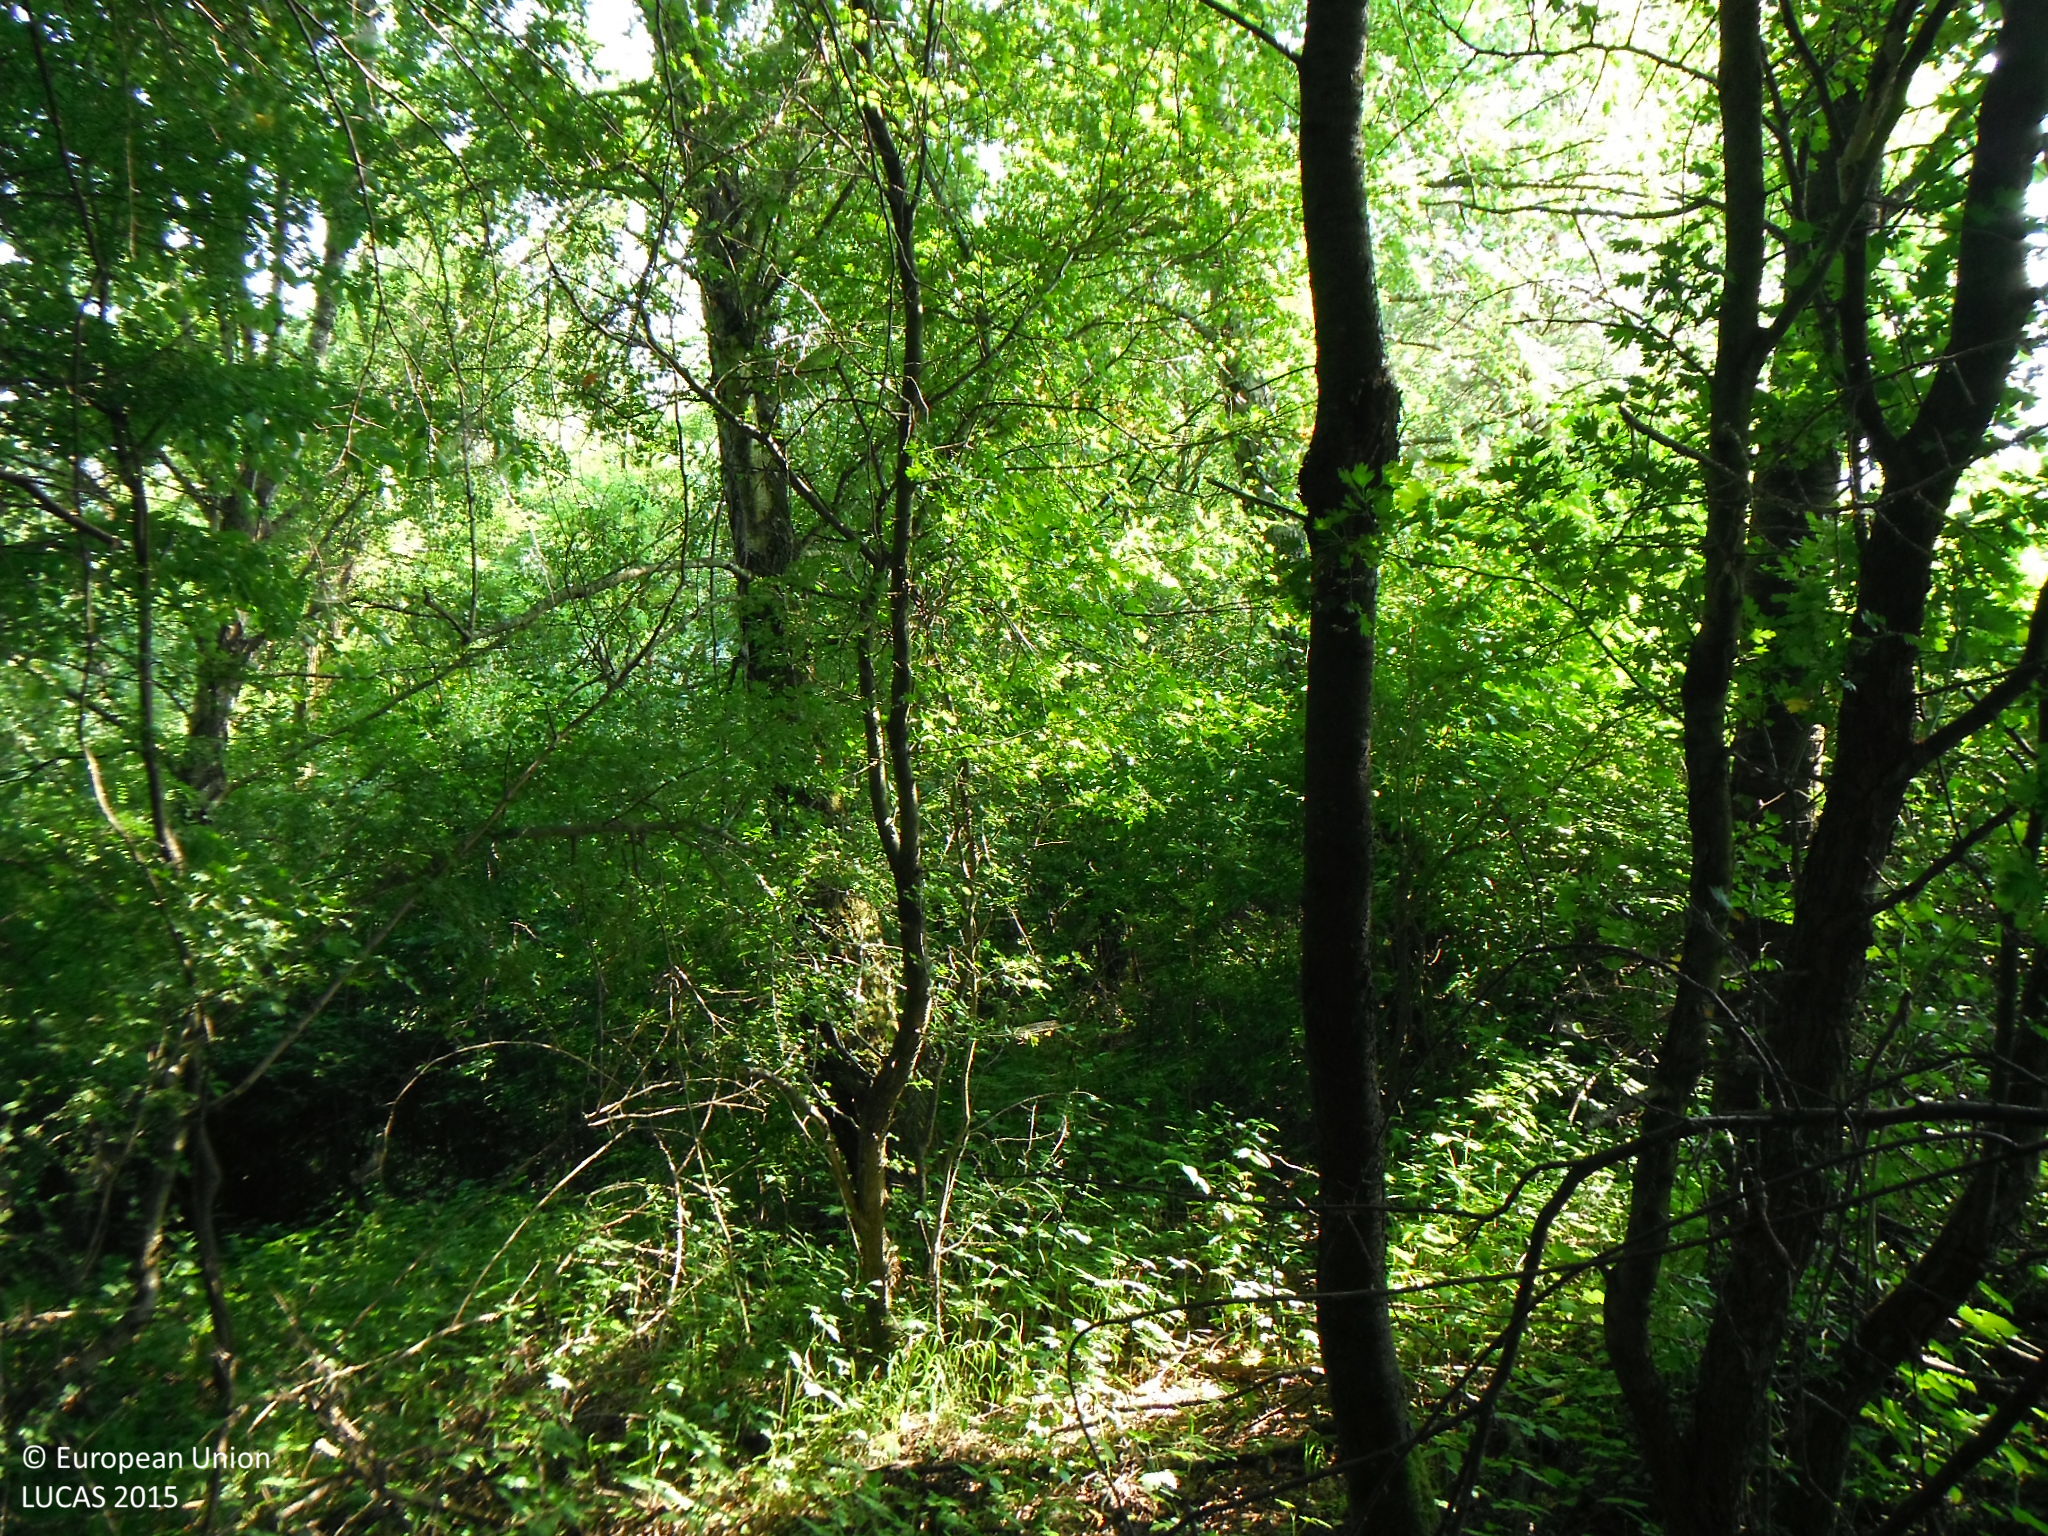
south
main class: Woodland
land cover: Broadleaved woodland
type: mesophytic deciduous forest
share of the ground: > 75 %
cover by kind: broadleaved forest trees 90 %, shrubs 10 %
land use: Semi-natural and natural areas not in use
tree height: > 5 m
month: July
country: SK
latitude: 49.3242
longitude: 21.1755
